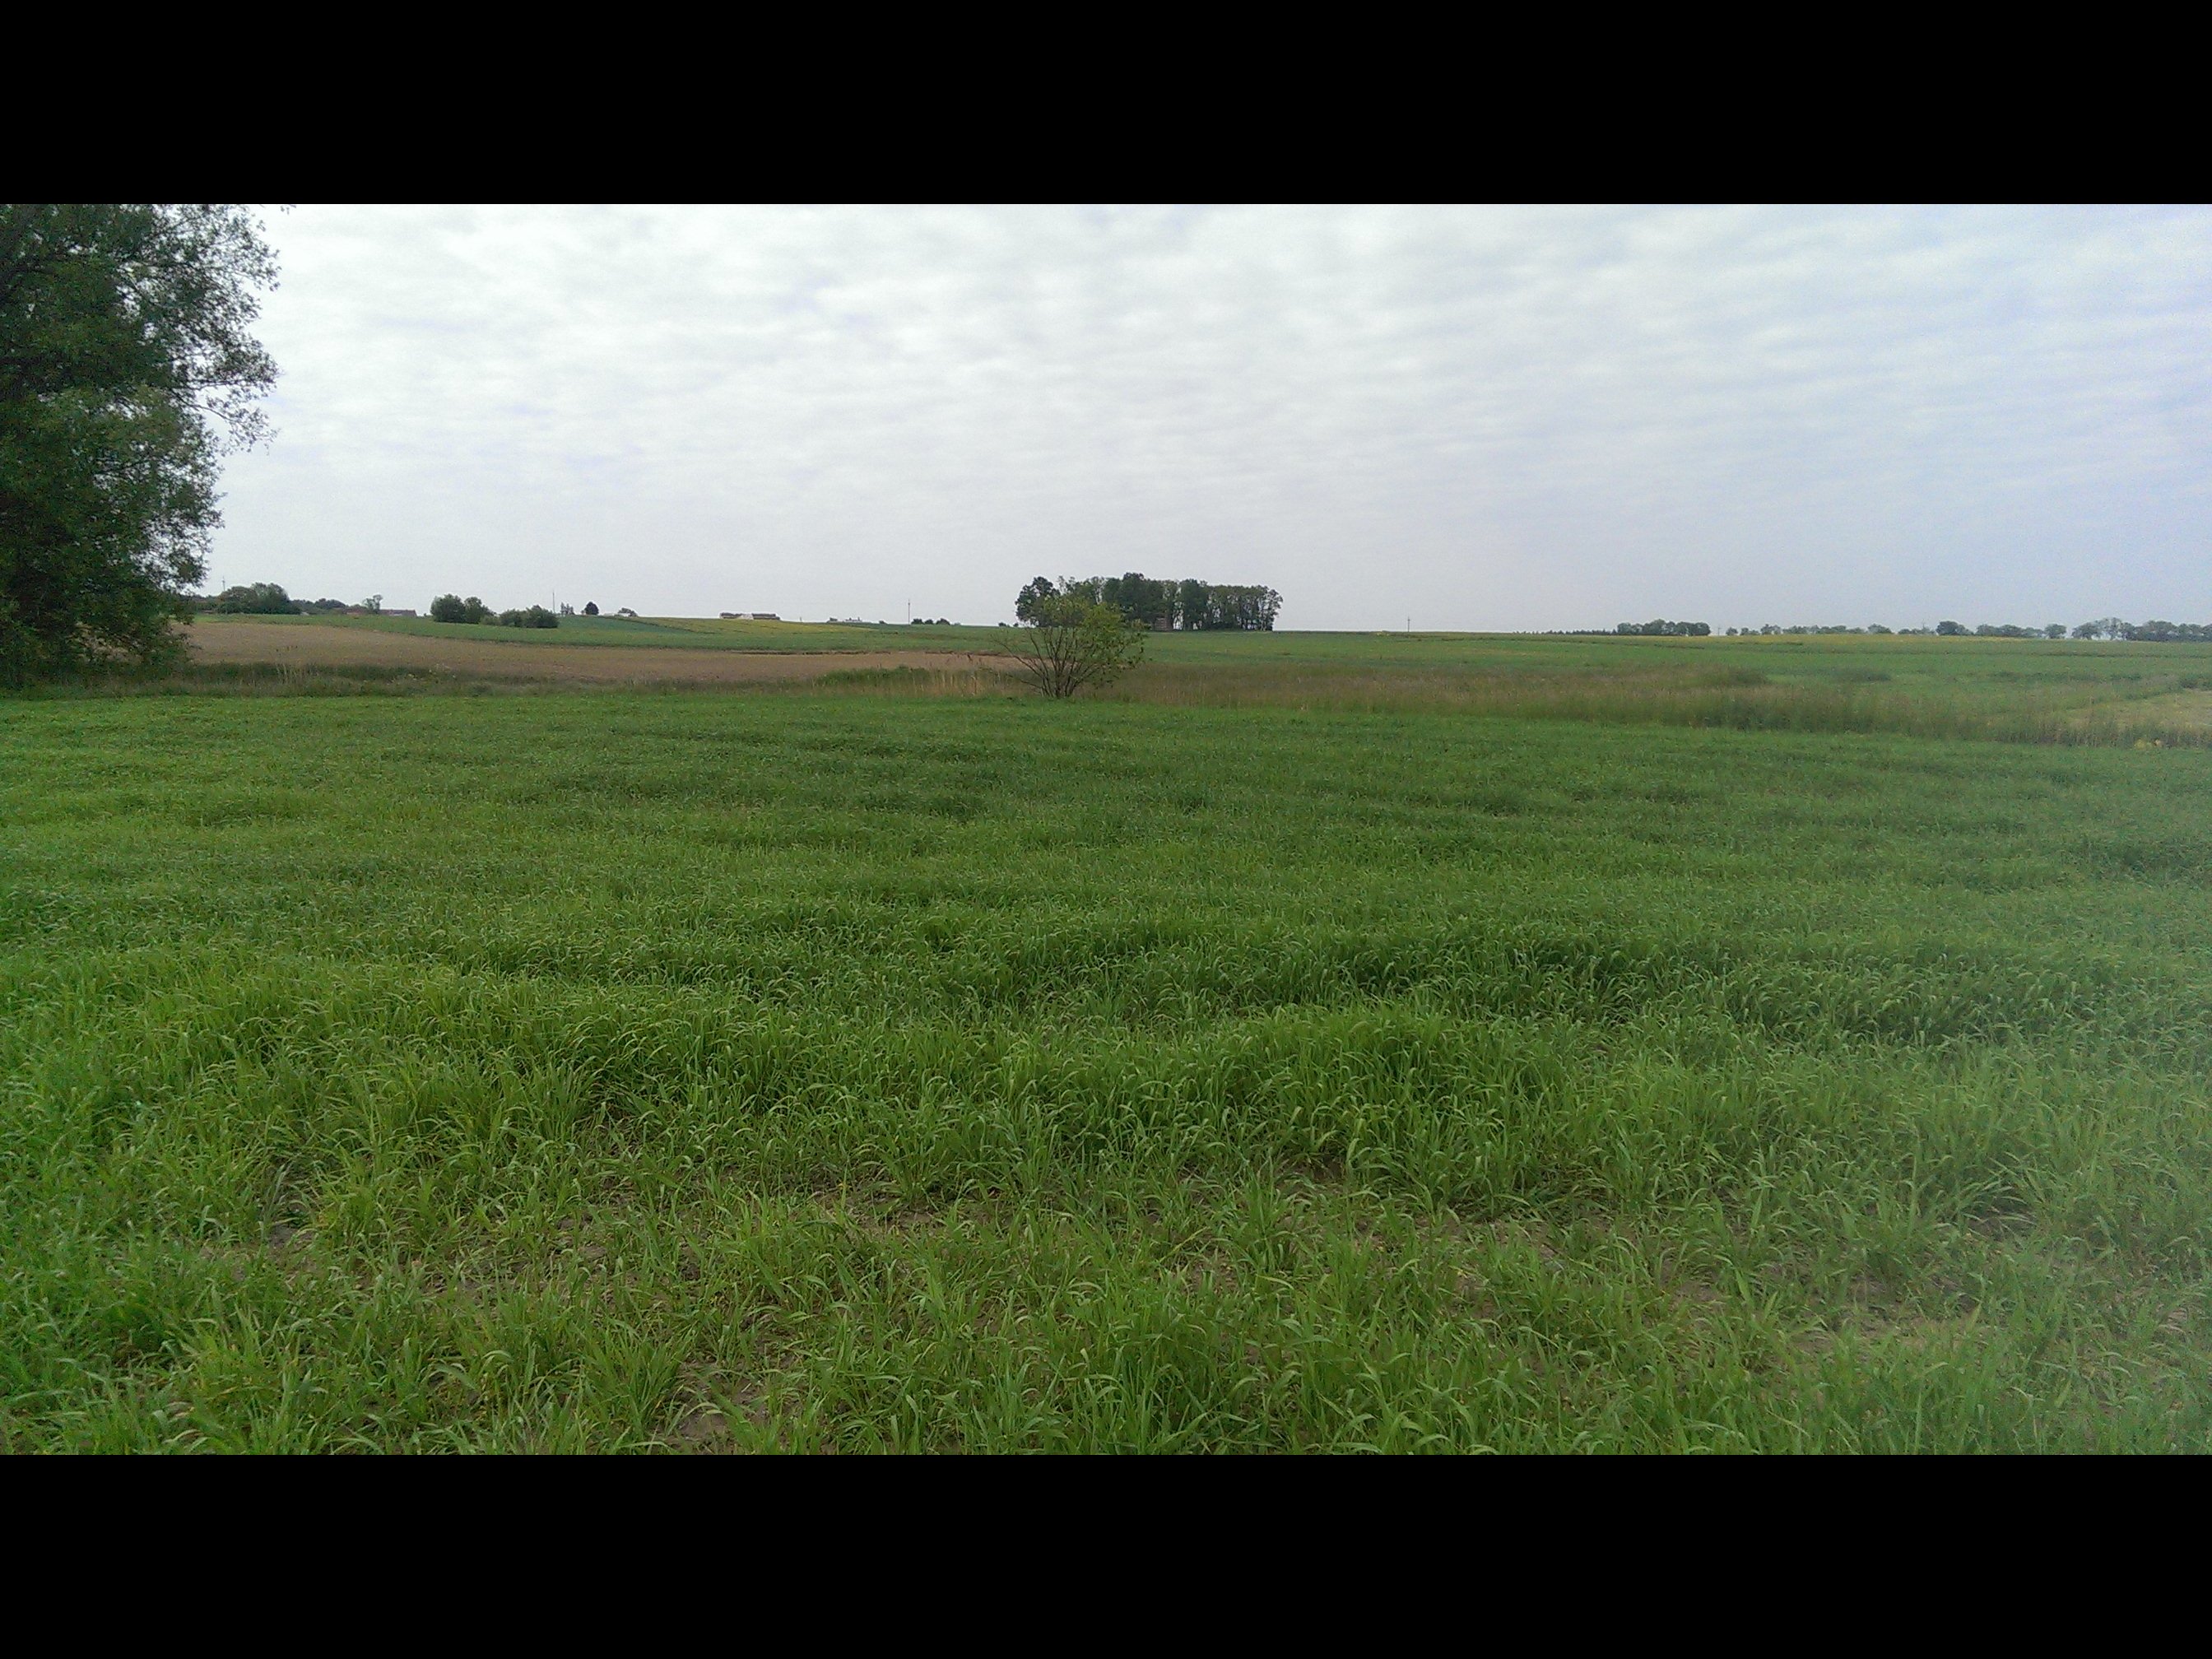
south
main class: Cropland
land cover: Barley
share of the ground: > 75 %
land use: Agriculture (excluding fallow land and kitchen gardens)
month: May
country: PL
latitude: 52.4094
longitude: 16.2838
